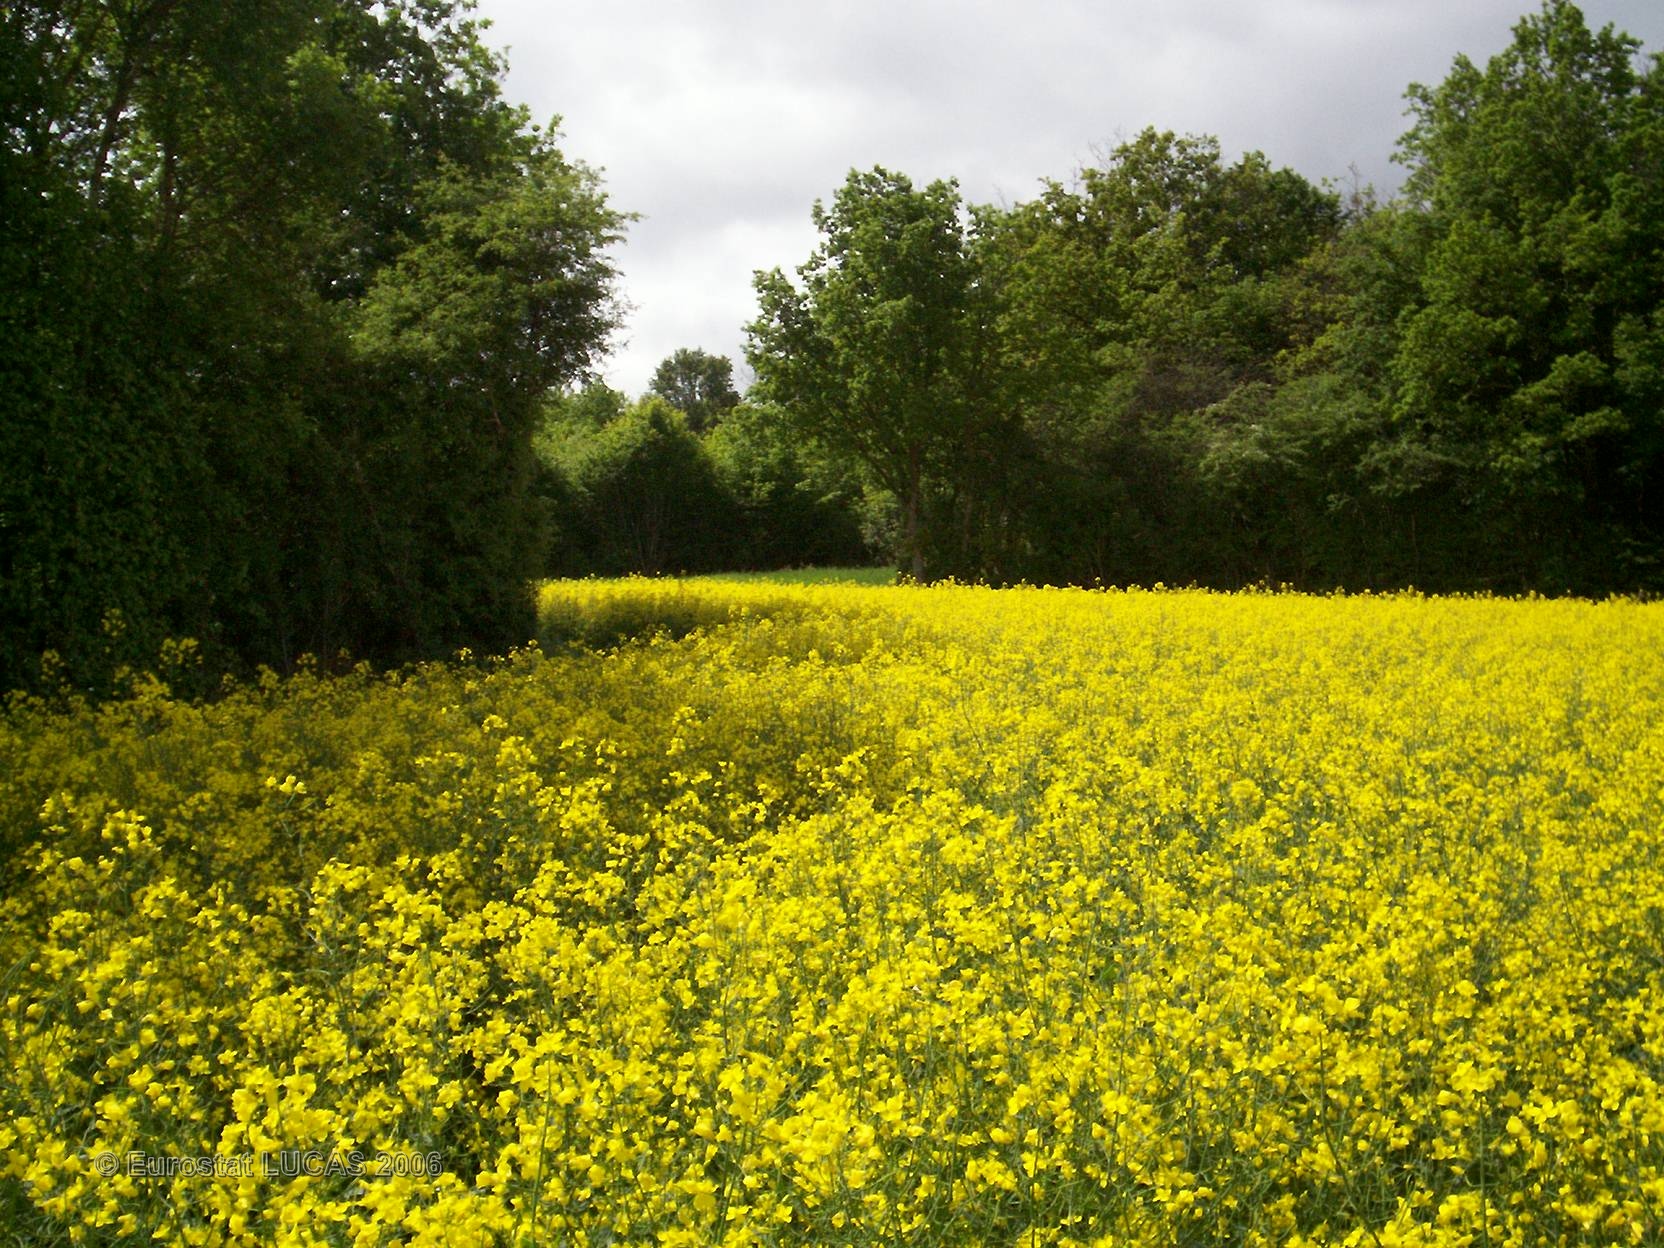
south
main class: Cropland
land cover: Rape and turnip rape
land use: Agriculture (excluding fallow land and kitchen gardens)
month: May
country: FR
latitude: 47.0664
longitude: 4.6676
